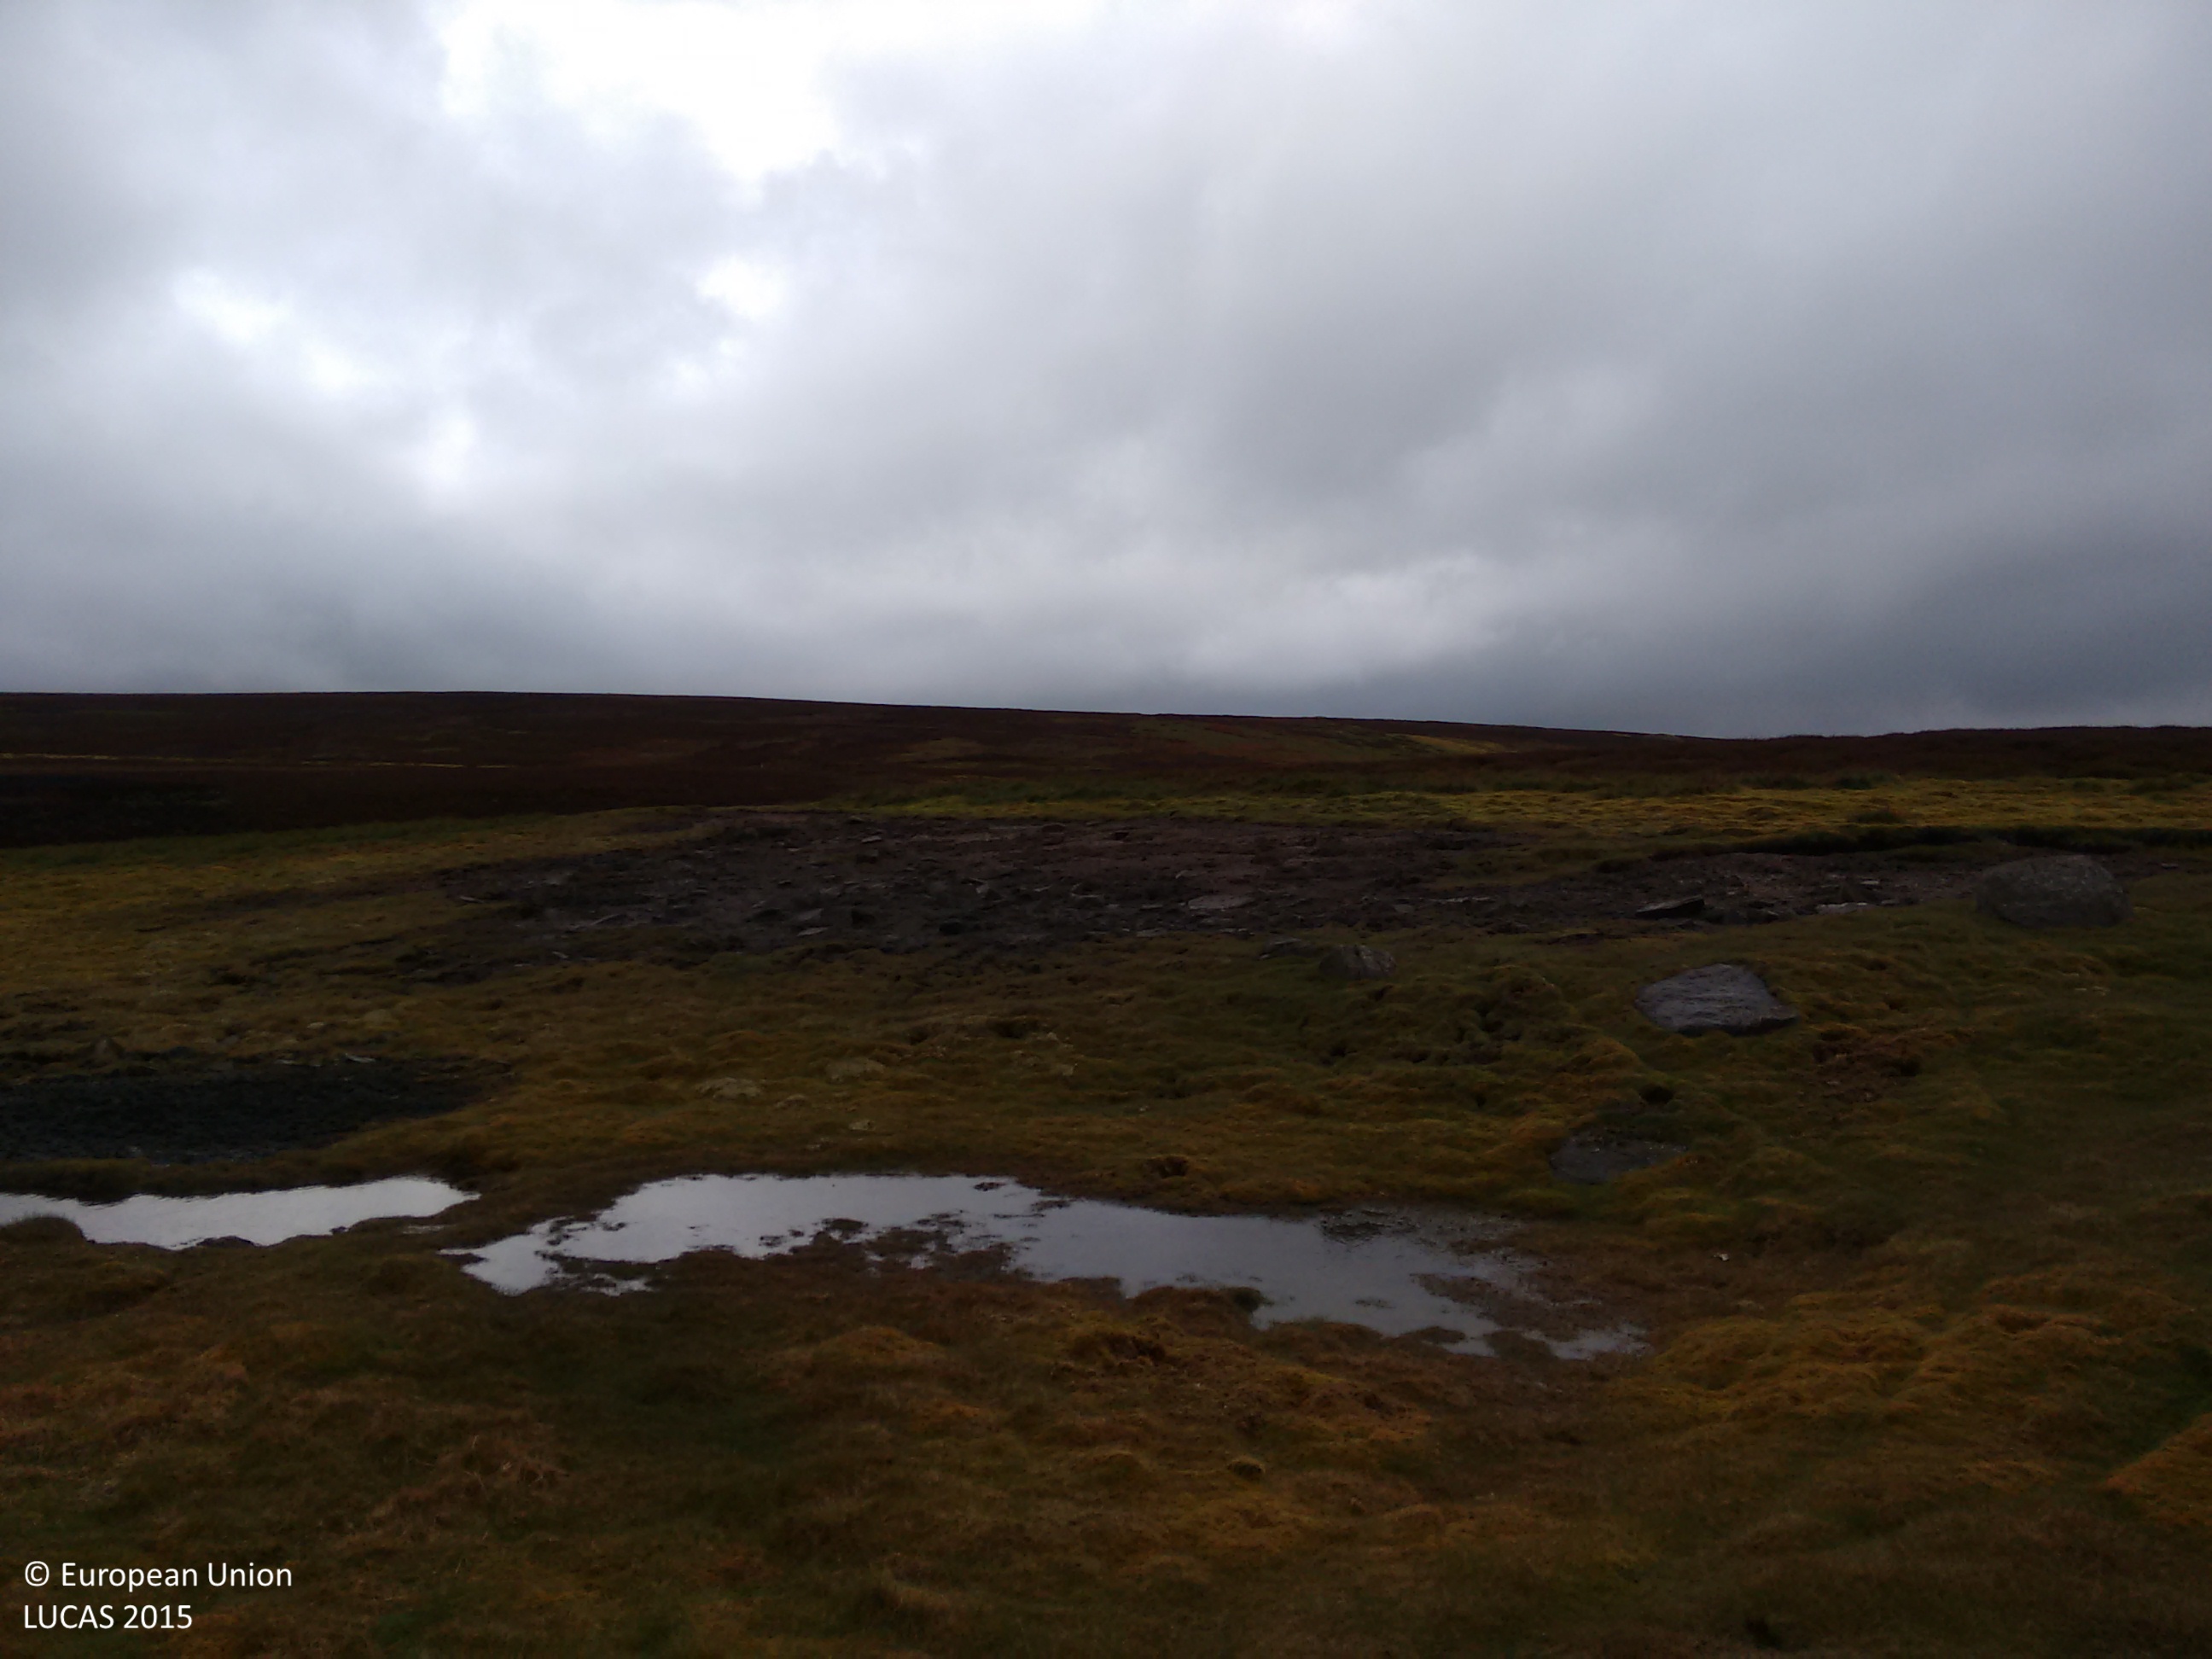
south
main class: Grassland
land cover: Grassland without tree/shrub cover
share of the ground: > 75 %
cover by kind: herbaceous plants 100 %
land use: Agriculture (excluding fallow land and kitchen gardens)
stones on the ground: < 10 %
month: June
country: GB
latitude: 54.0970
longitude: -1.9679
